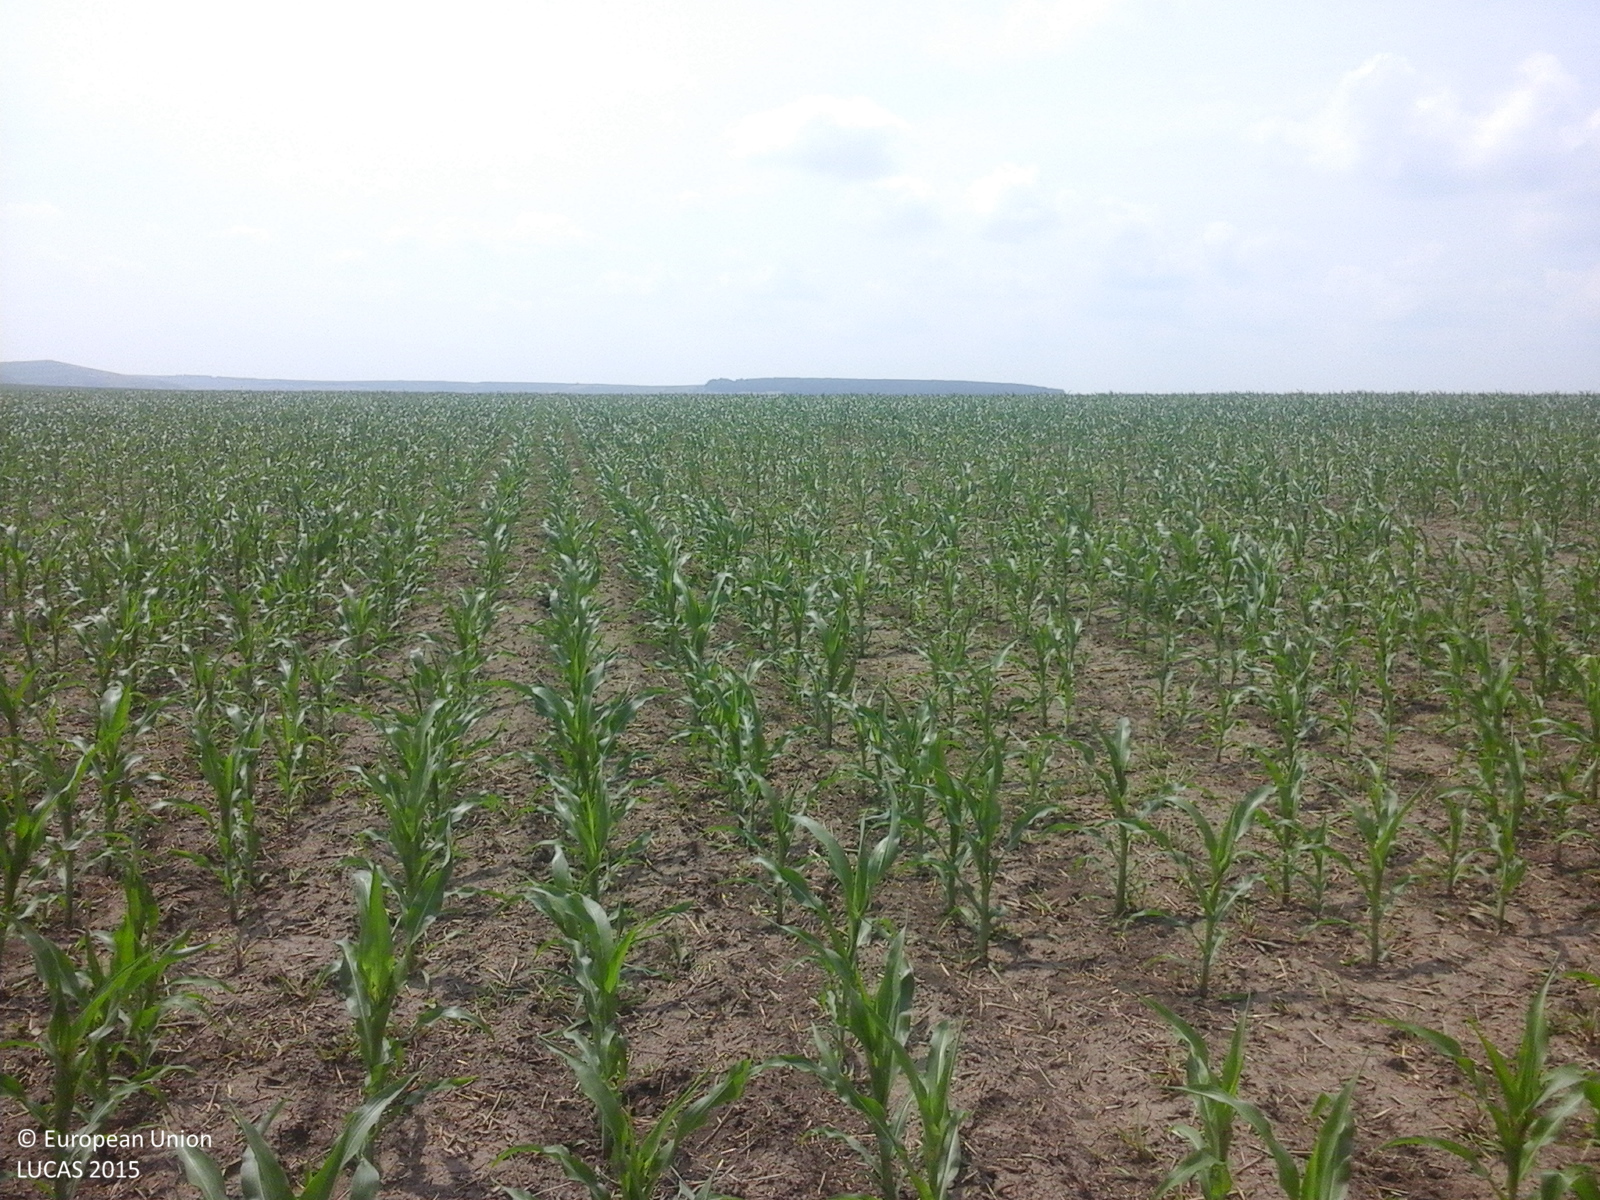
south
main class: Cropland
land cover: Maize
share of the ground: 50 - 75 %
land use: Agriculture (excluding fallow land and kitchen gardens)
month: June
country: RO
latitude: 47.4011
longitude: 27.0239
